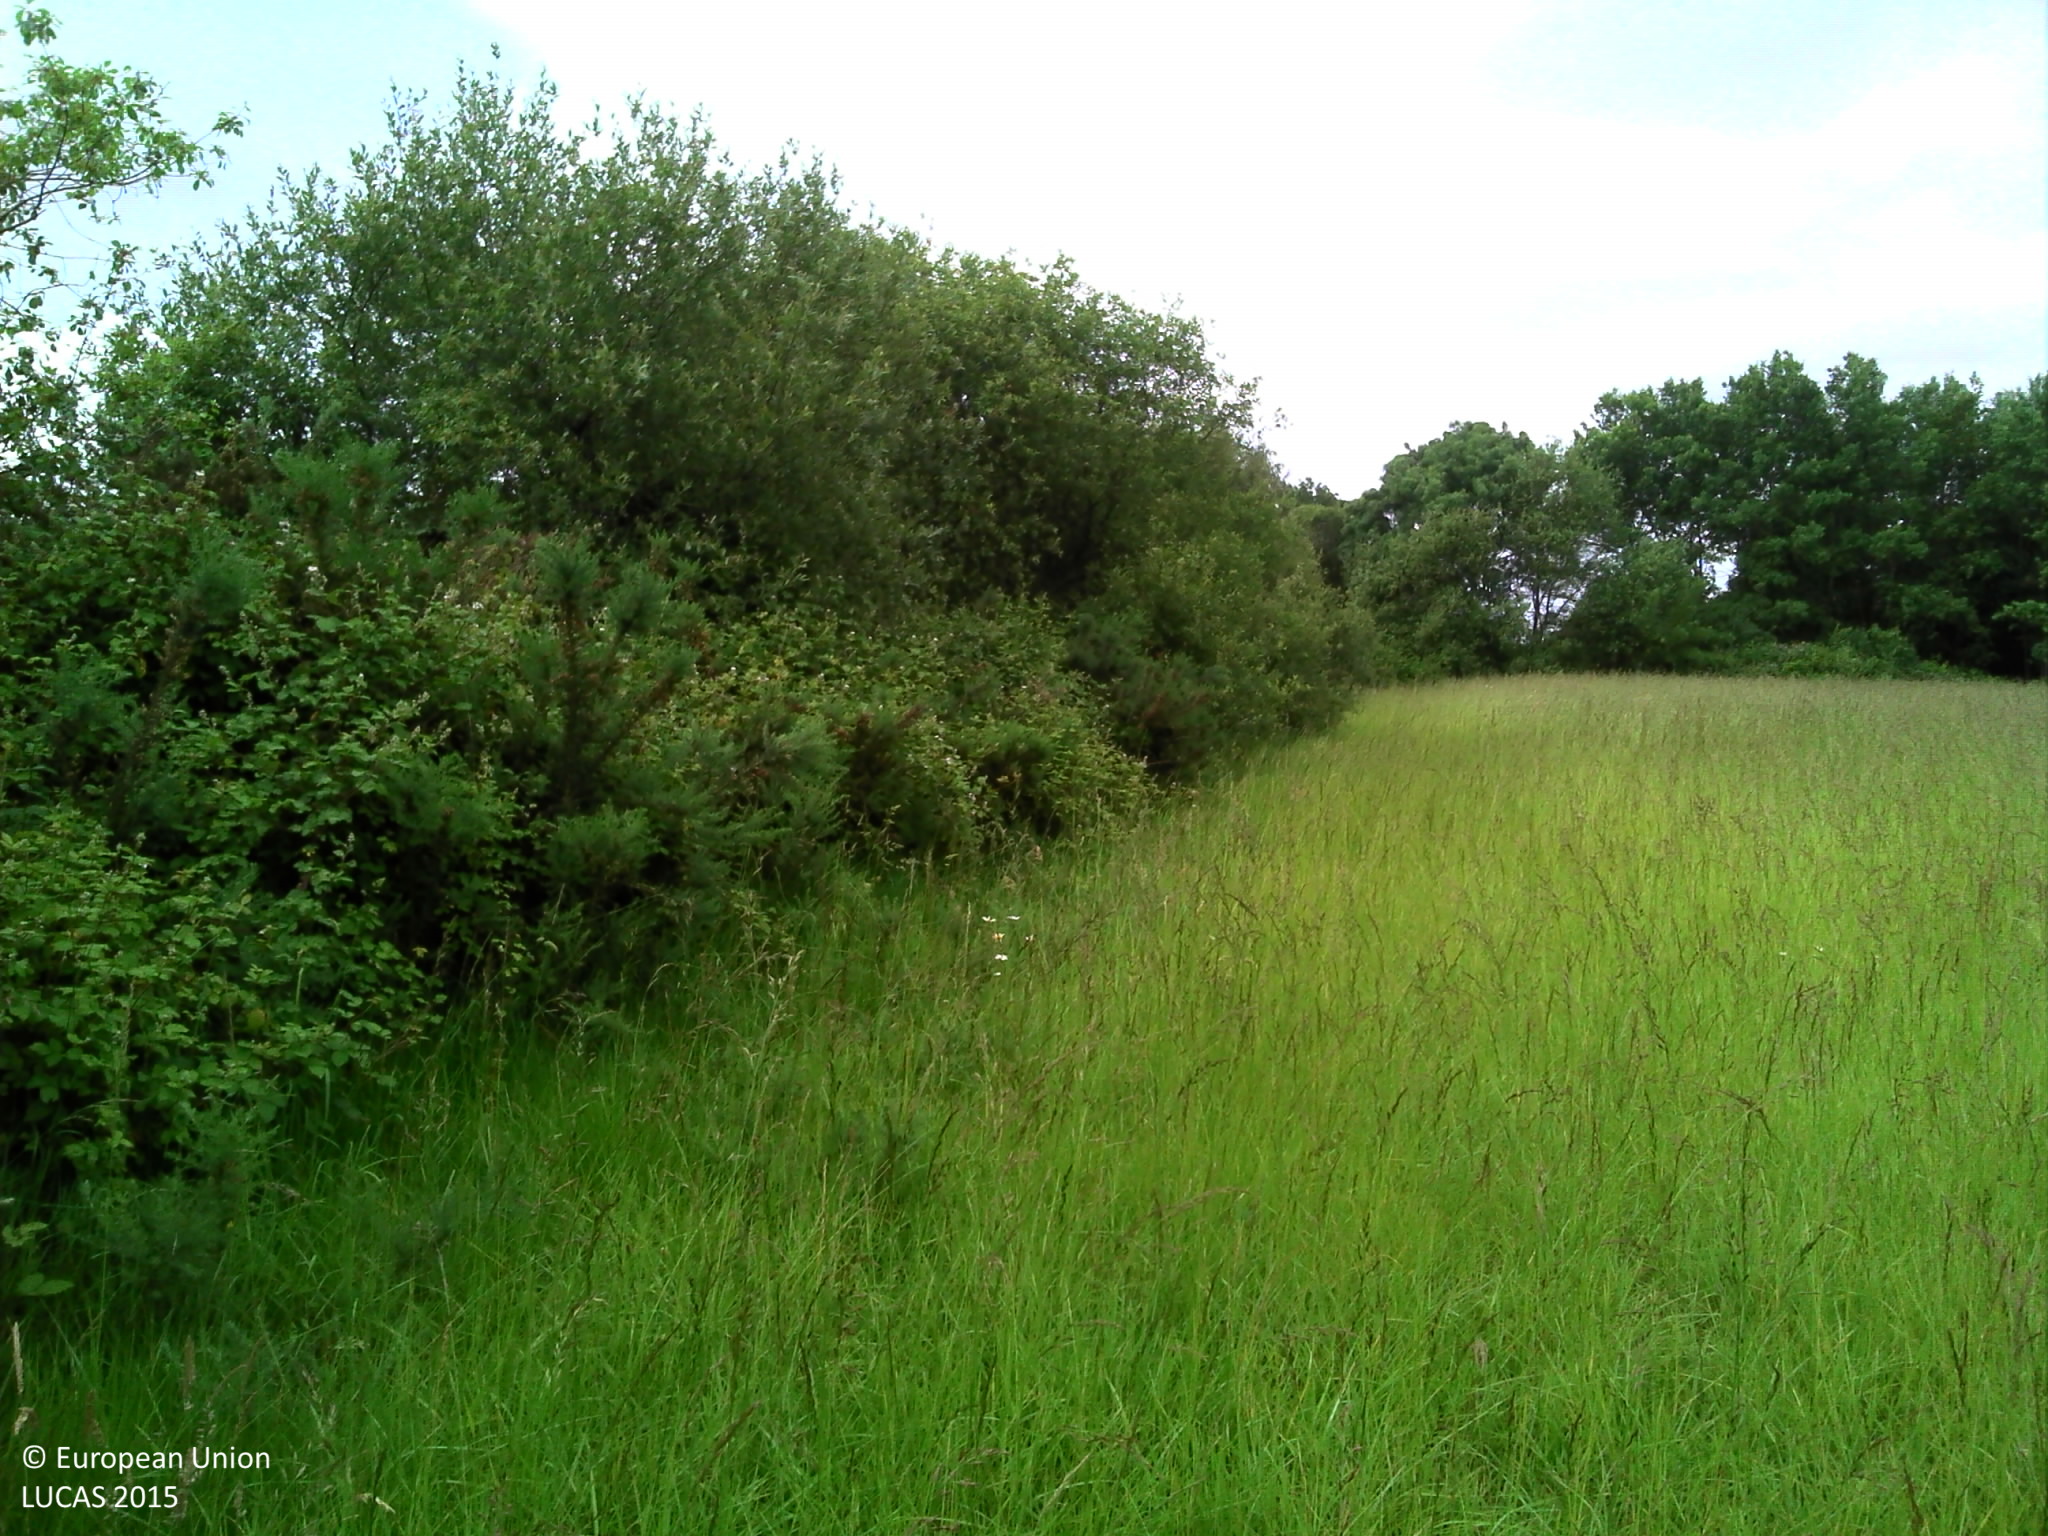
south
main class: Grassland
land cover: Grassland without tree/shrub cover
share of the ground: > 75 %
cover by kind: herbaceous plants 100 %
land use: Agriculture (excluding fallow land and kitchen gardens)
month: June
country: FR
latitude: 47.2277
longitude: -1.2513
